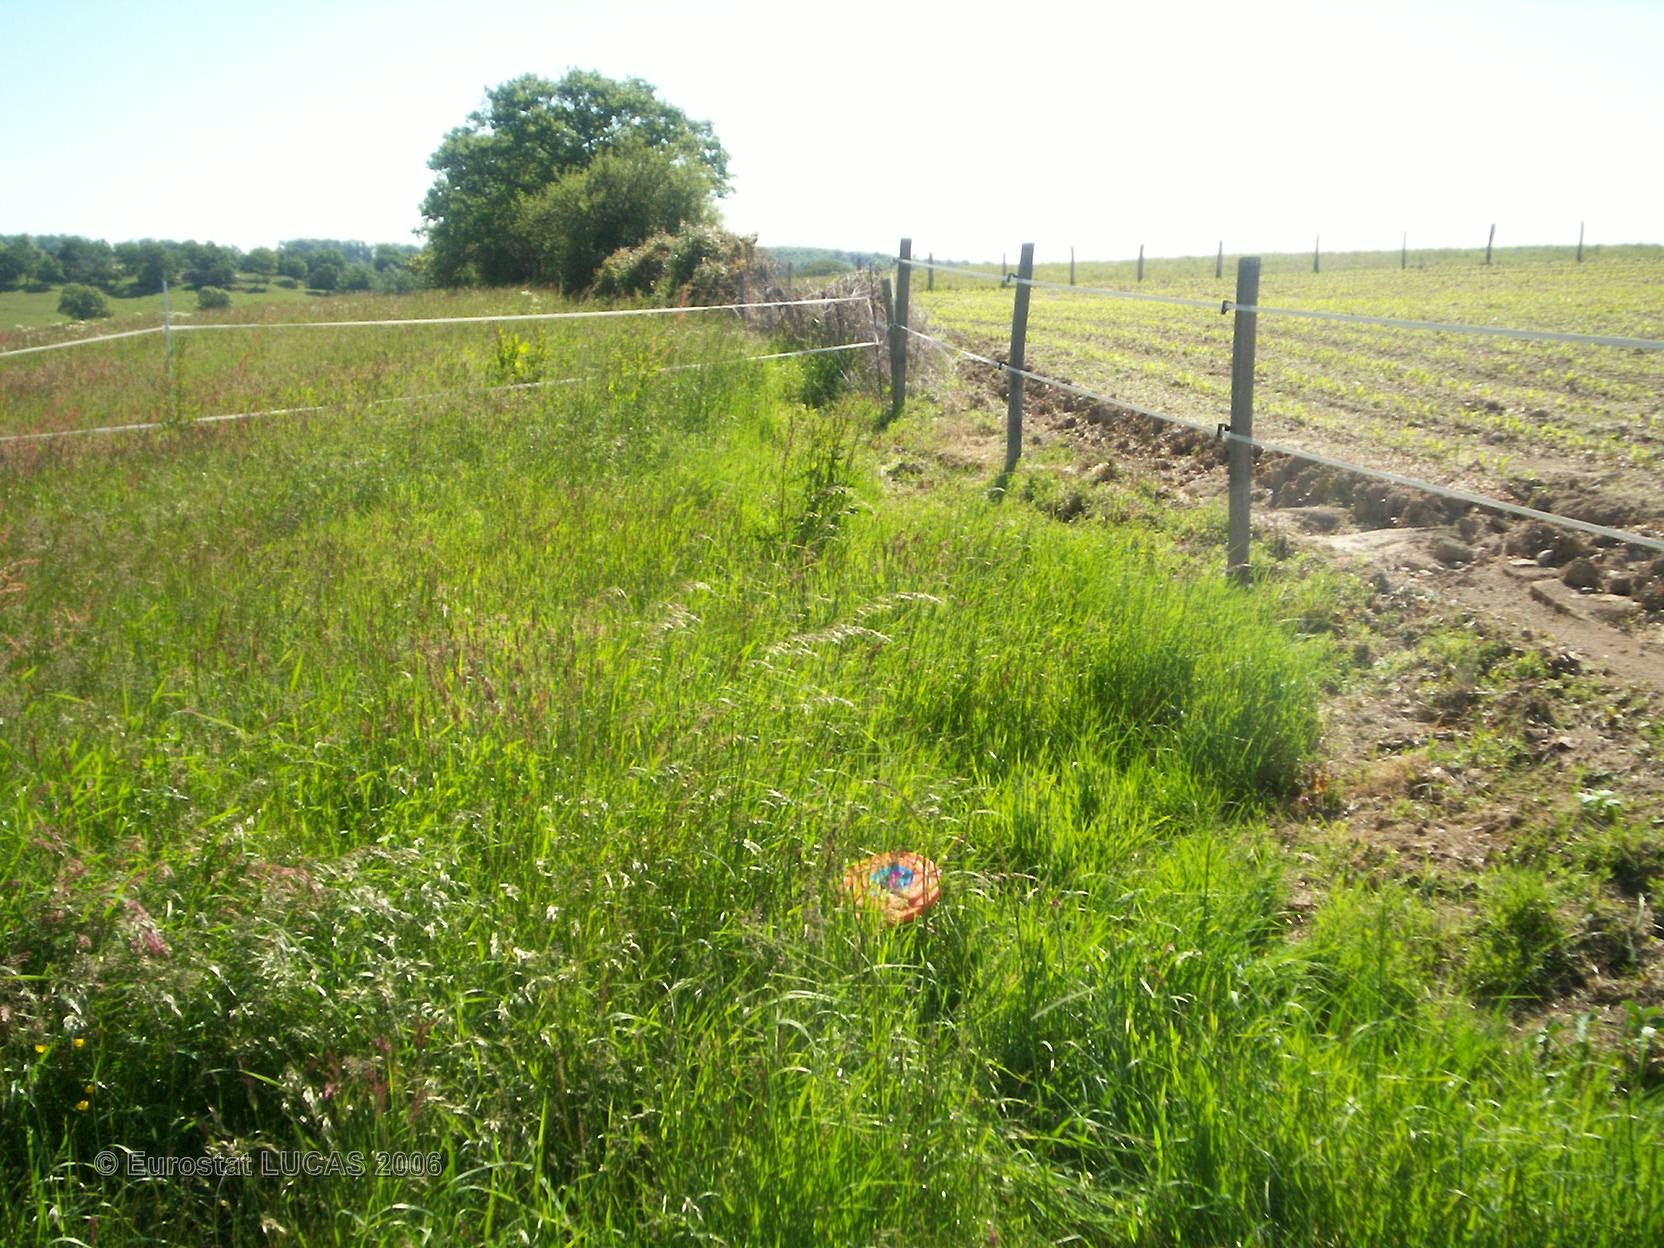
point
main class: Grassland
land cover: Grassland without tree/shrub cover
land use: Agriculture (excluding fallow land and kitchen gardens)
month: June
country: FR
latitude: 46.1395
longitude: 2.9950
